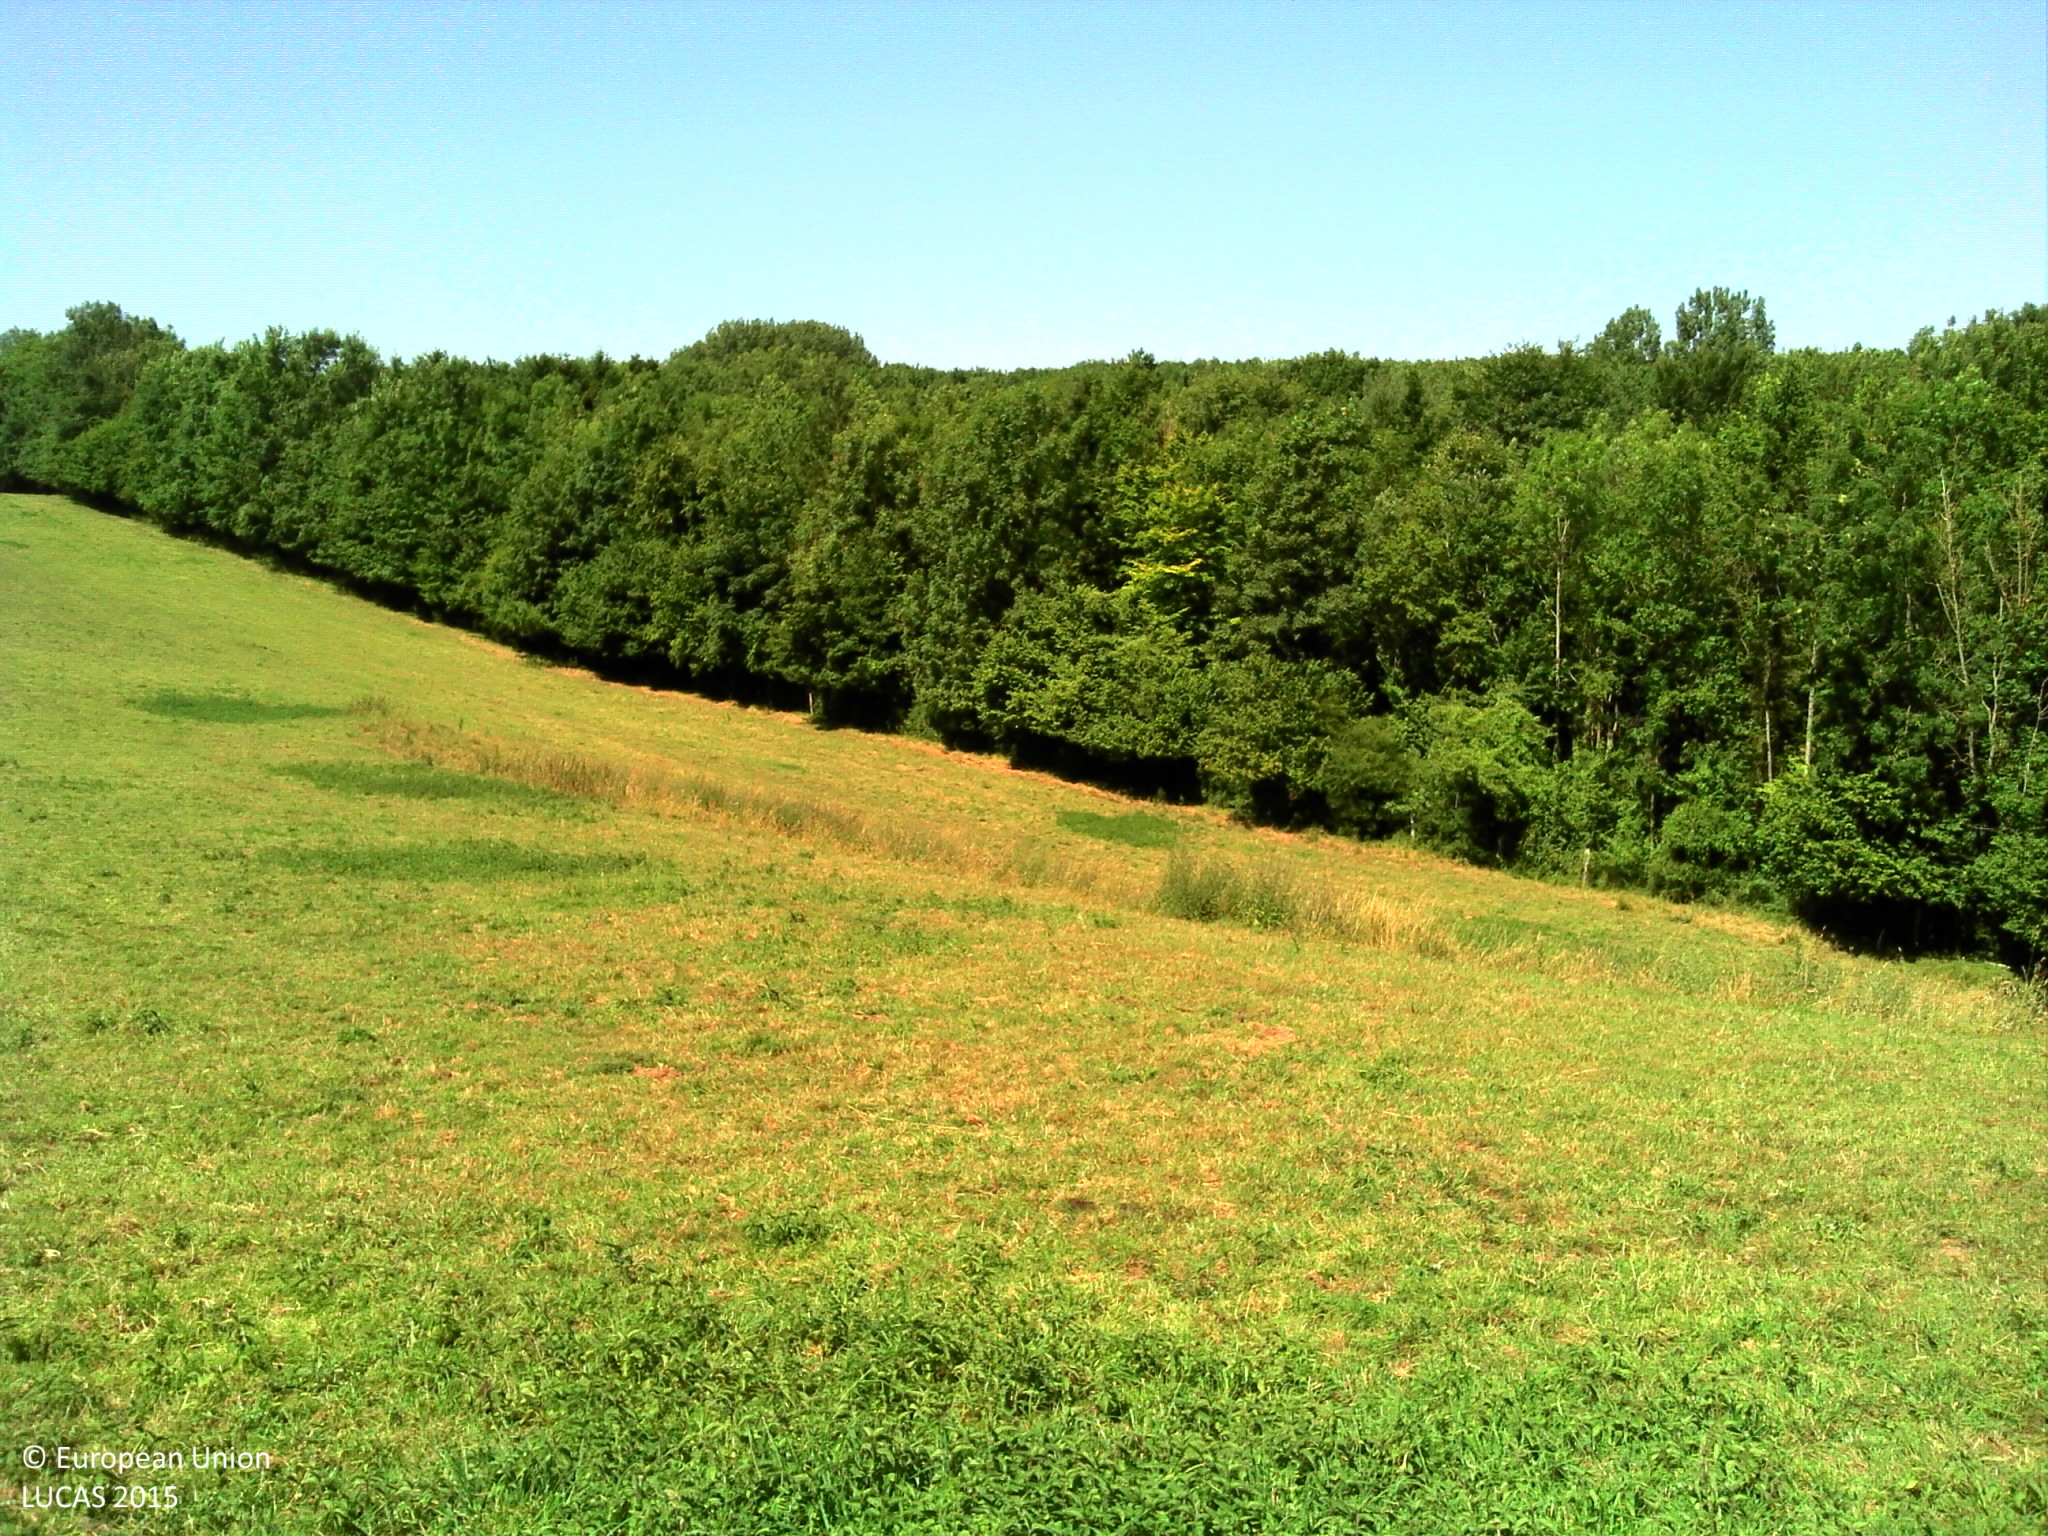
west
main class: Grassland
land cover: Grassland without tree/shrub cover
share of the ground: > 75 %
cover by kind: herbaceous plants 95 %
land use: Agriculture (excluding fallow land and kitchen gardens)
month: July
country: FR
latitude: 50.3258
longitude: 2.1049
